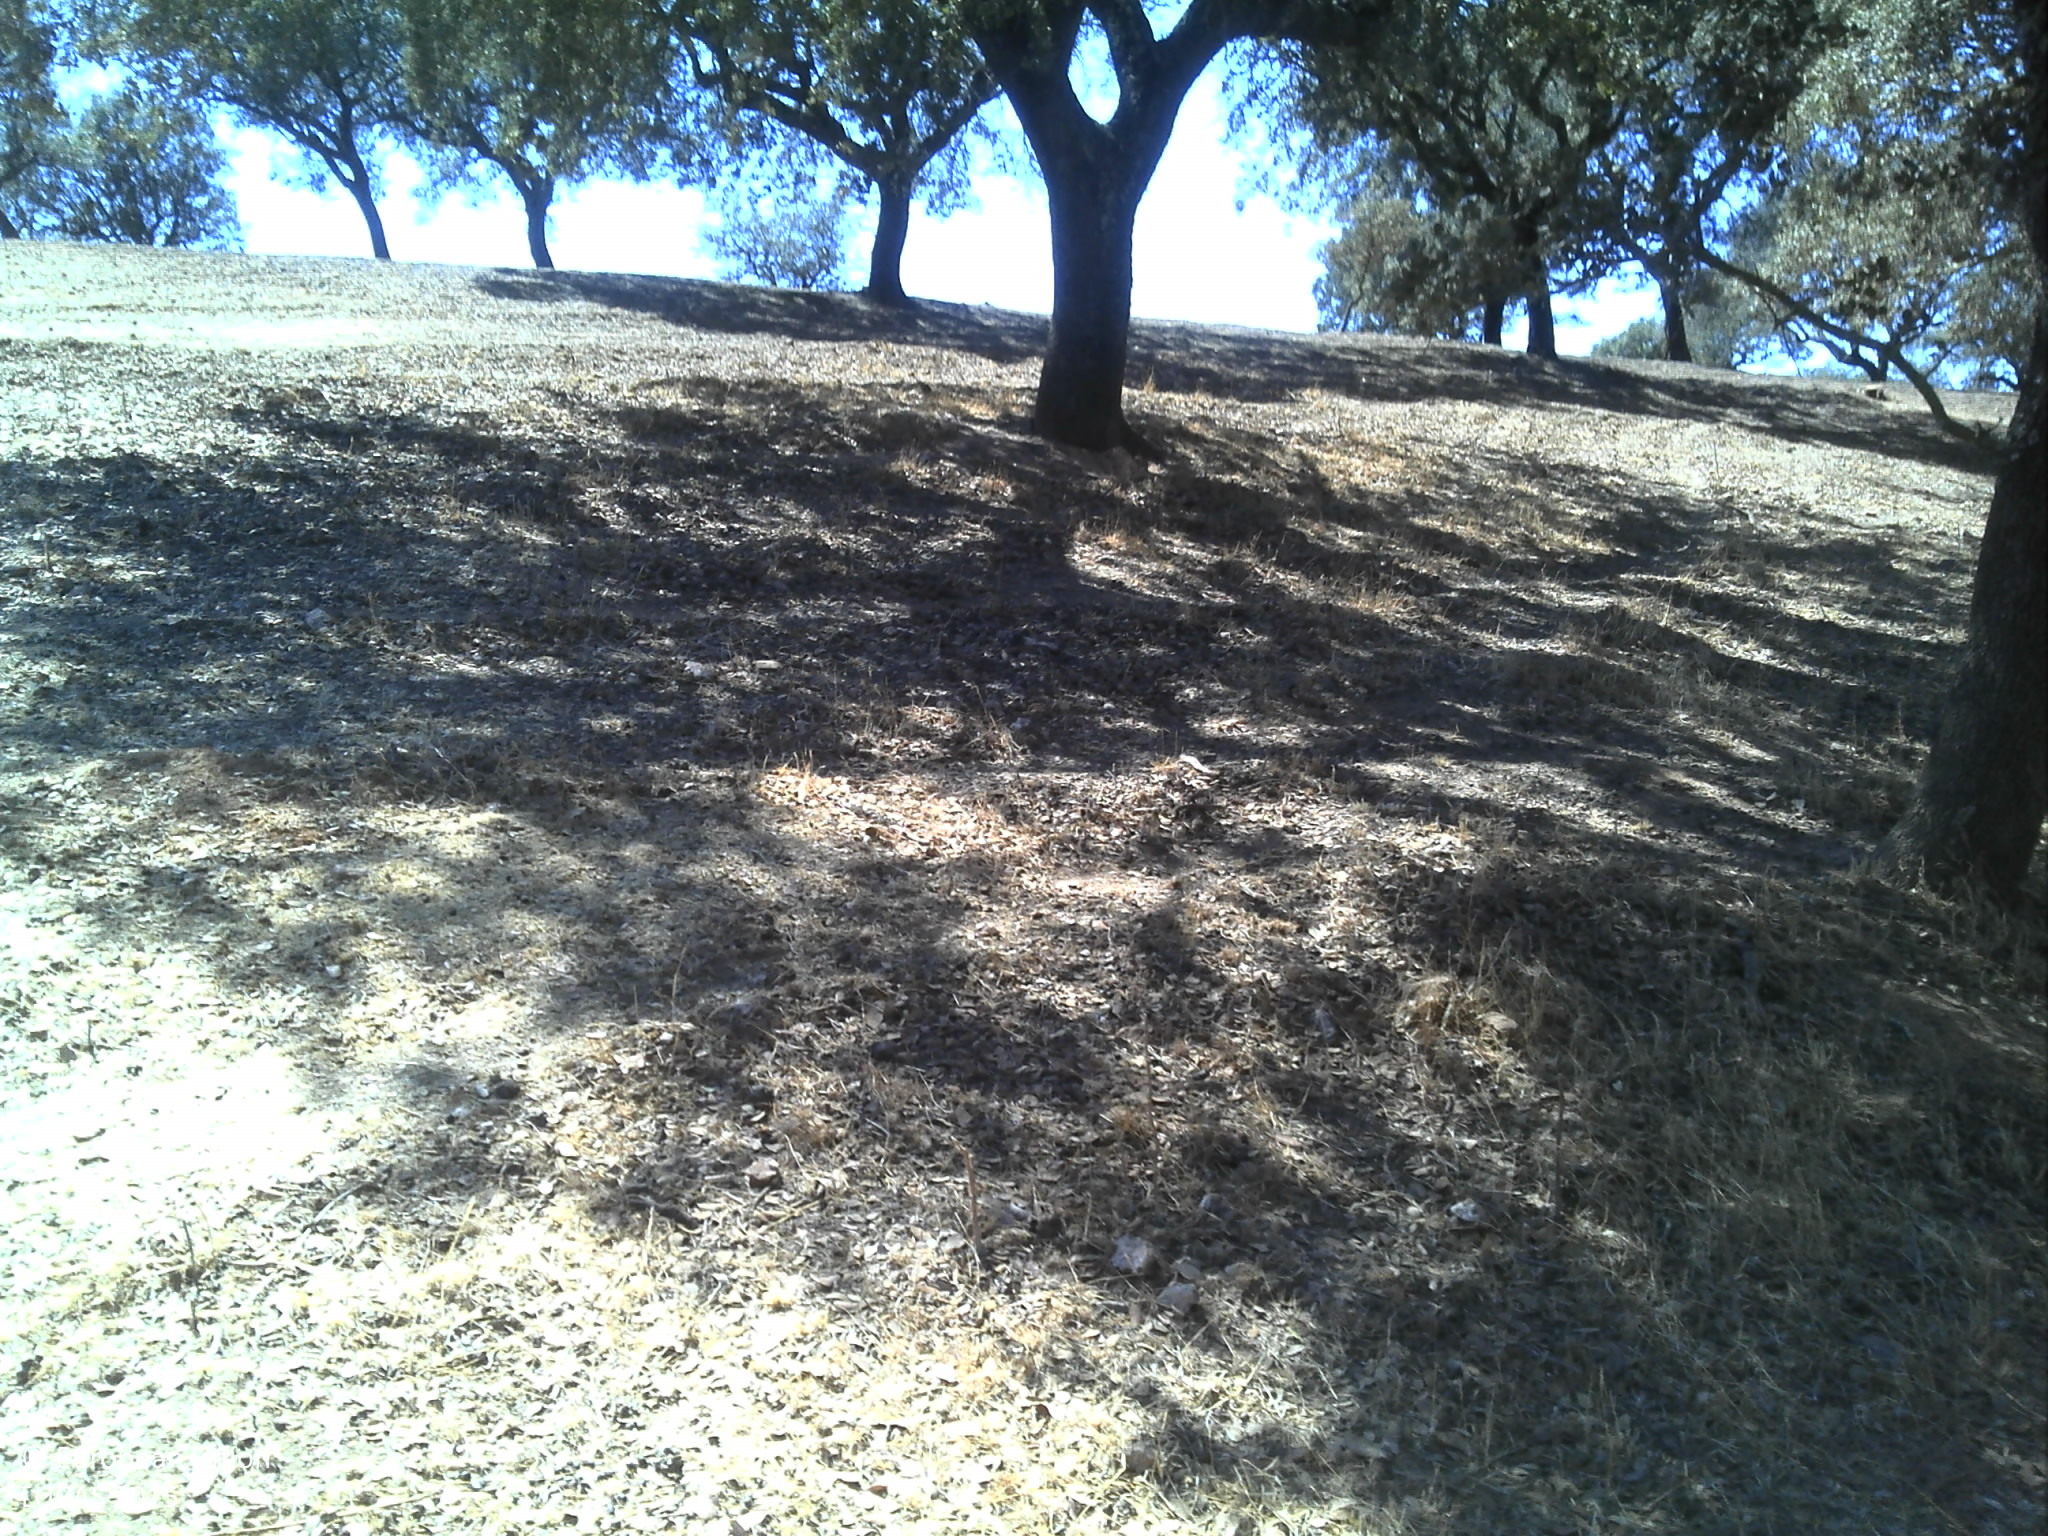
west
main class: Woodland
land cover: Broadleaved woodland
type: broadleaved evergreen forest
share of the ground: > 75 %
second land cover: Grassland without tree/shrub cover
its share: < 10 %
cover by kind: broadleaved forest trees 95 %, herbaceous plants 5 %
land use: Agriculture (excluding fallow land and kitchen gardens)
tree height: > 5 m
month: July
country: PT
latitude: 38.0022
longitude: -8.0598
